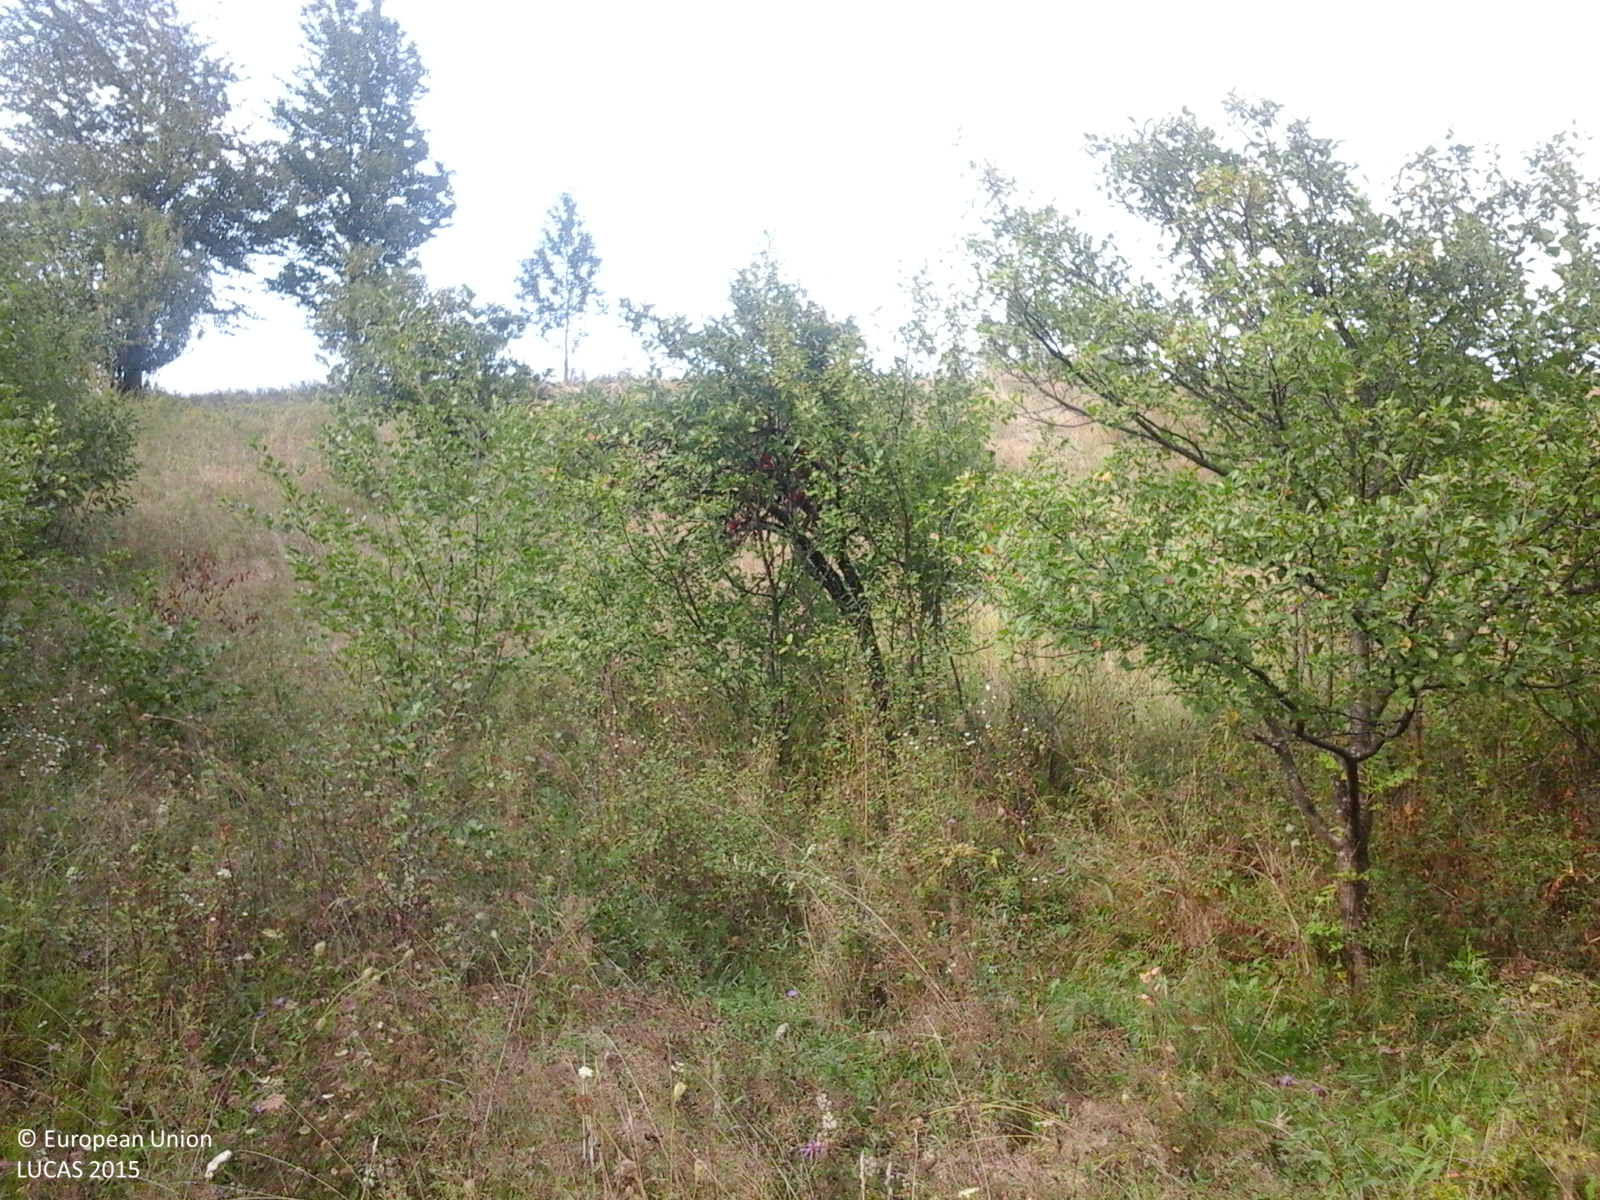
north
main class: Grassland
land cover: Grassland with sparse tree/shrub cover
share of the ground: > 75 %
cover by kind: herbaceous plants 85 %, shrubs 10 %, broadleaved forest trees 5 %
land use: Agriculture (excluding fallow land and kitchen gardens)
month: September
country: RO
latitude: 46.9296
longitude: 22.6250
